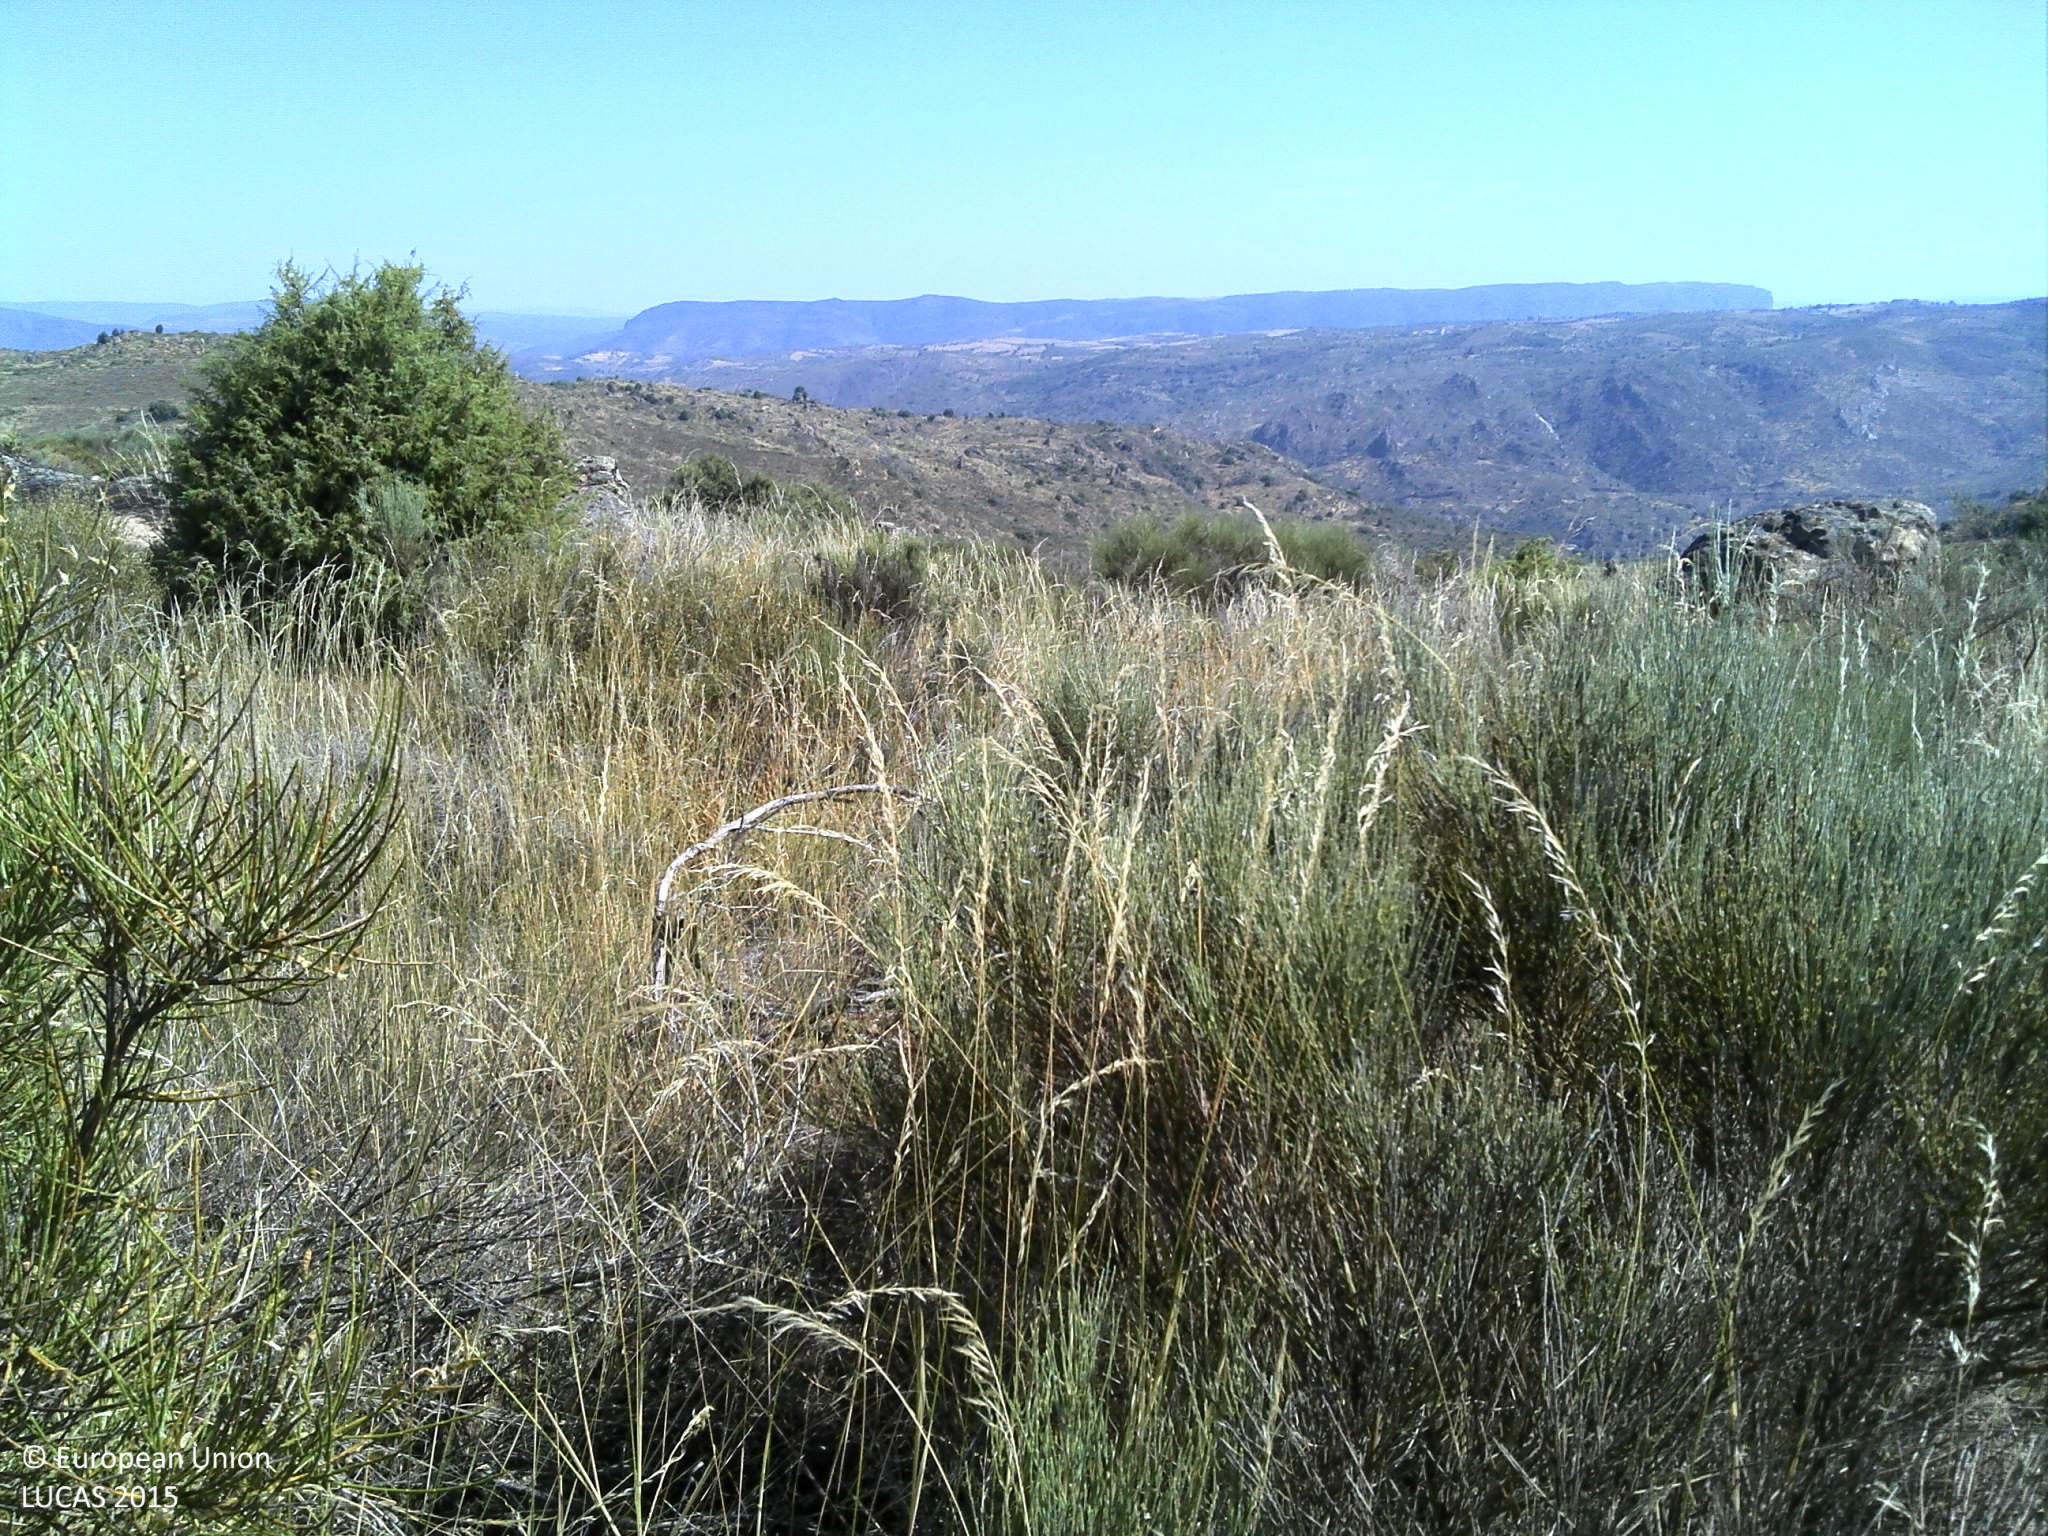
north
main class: Shrubland
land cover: Shrubland with sparse tree cover
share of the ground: > 75 %
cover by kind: shrubs 95 %, coniferous forest trees 5 %
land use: Semi-natural and natural areas not in use
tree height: < 5 m
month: June
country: PT
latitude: 40.9475
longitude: -6.8885
